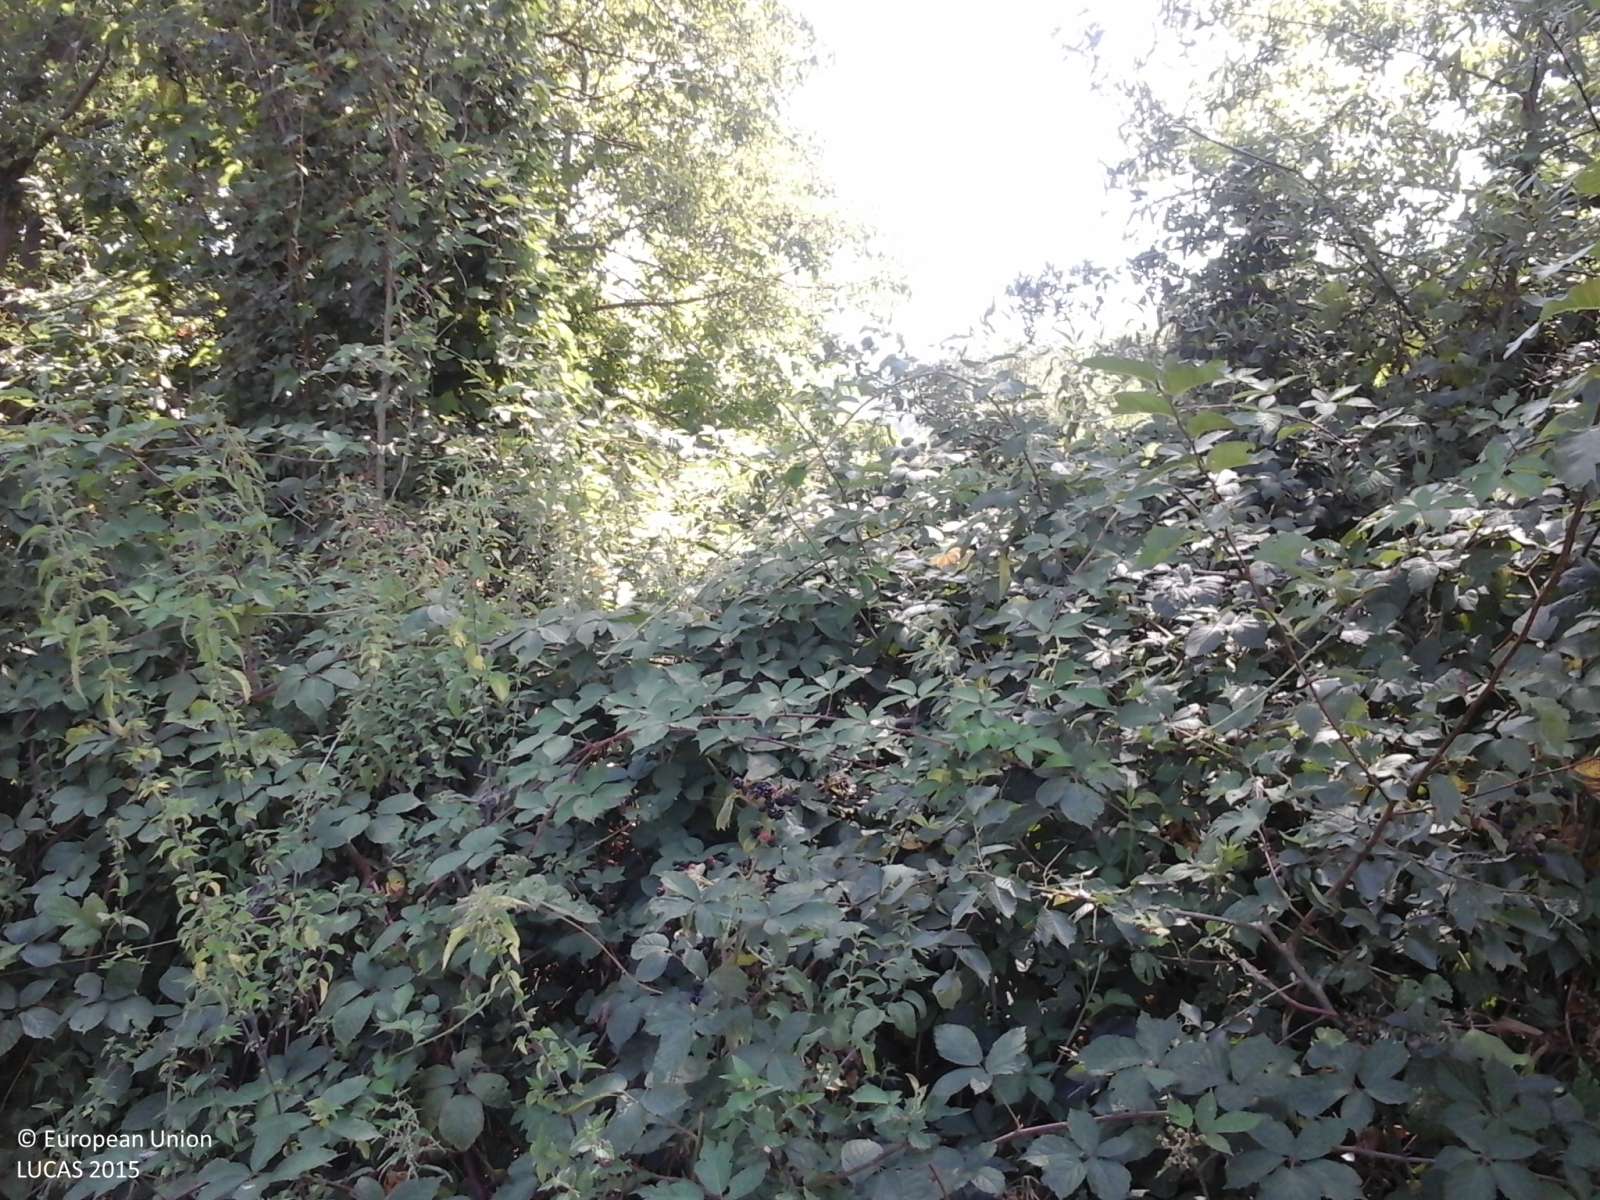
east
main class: Woodland
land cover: Broadleaved woodland
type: thermophilous deciduous forest
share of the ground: > 75 %
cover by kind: broadleaved forest trees 80 %, shrubs 20 %
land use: Semi-natural and natural areas not in use
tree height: > 5 m
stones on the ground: < 10 %
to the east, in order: Broadleaved woodland; Inland fresh running water; Broadleaved woodland; Inland fresh running water; Broadleaved woodland; Grassland without tree/shrub cover; Ditches and canals; Tracks; Grassland without tree/shrub cover
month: August
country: IT
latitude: 44.3450
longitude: 7.7845
